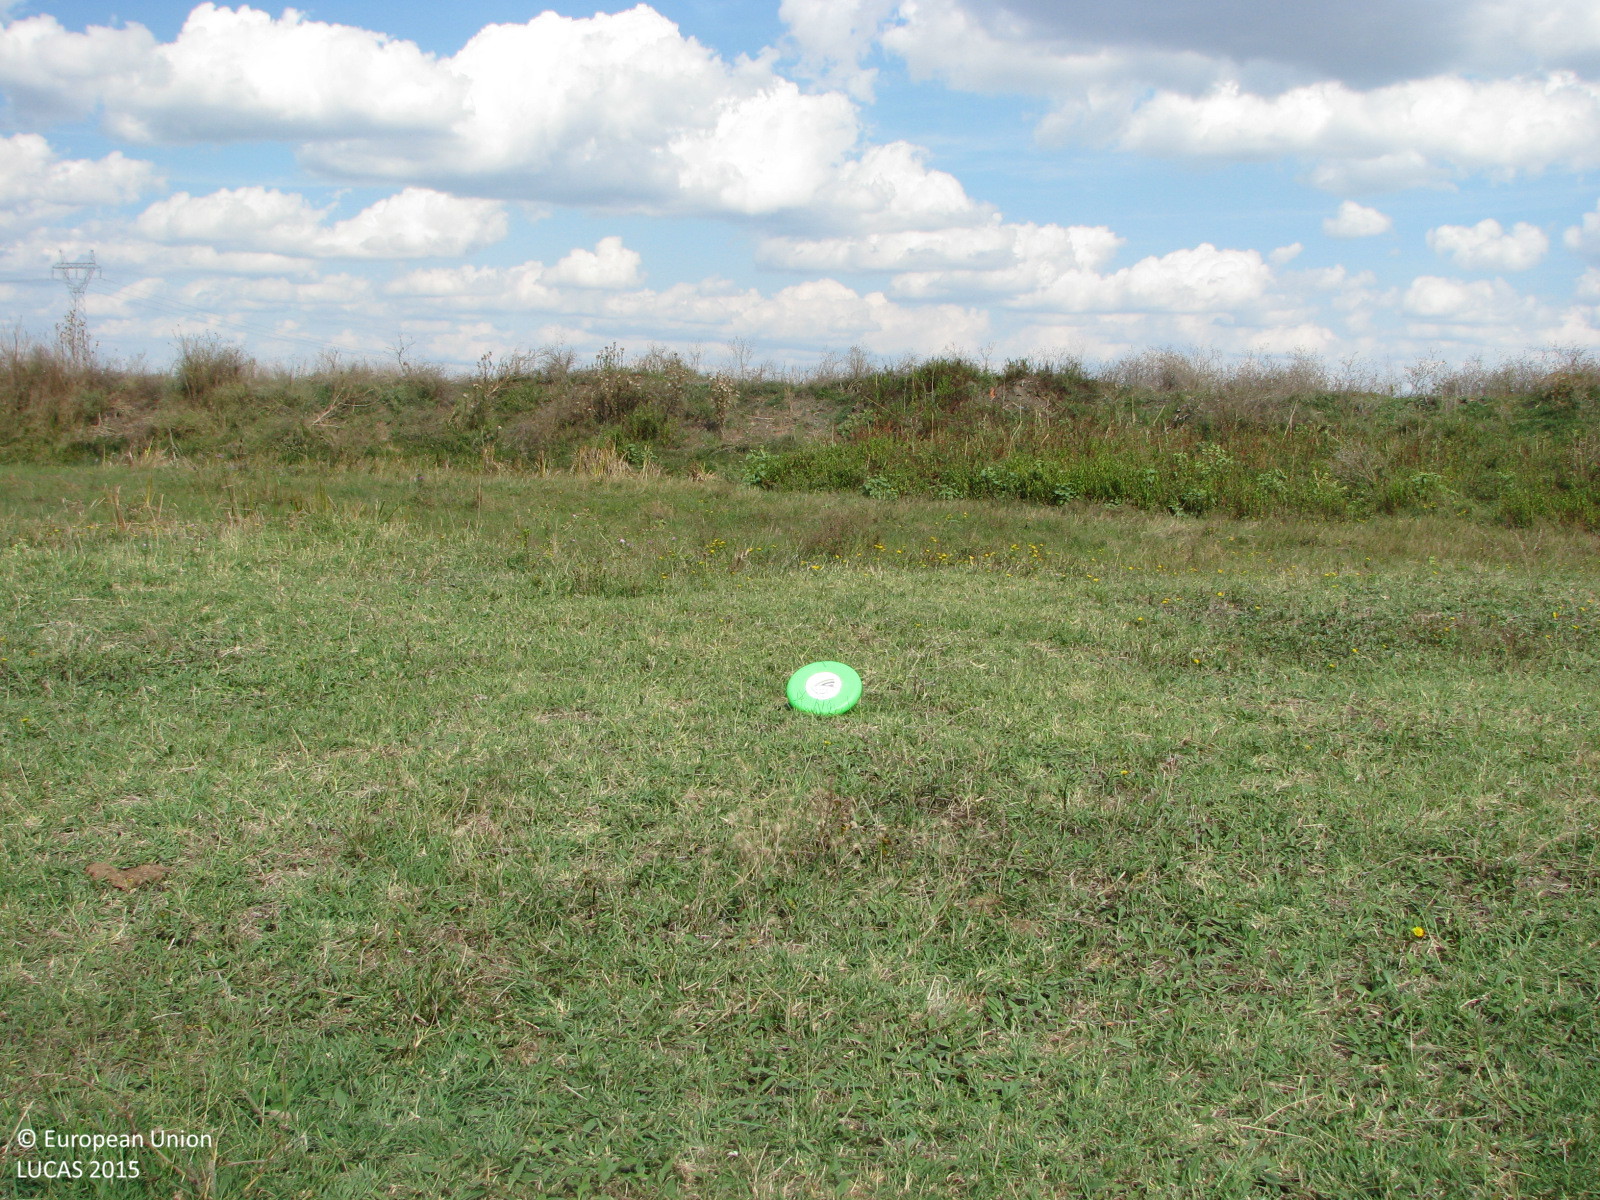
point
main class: Grassland
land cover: Grassland without tree/shrub cover
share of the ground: > 75 %
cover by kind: herbaceous plants 100 %
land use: Agriculture (excluding fallow land and kitchen gardens)
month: September
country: BG
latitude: 42.5545
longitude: 26.7479
